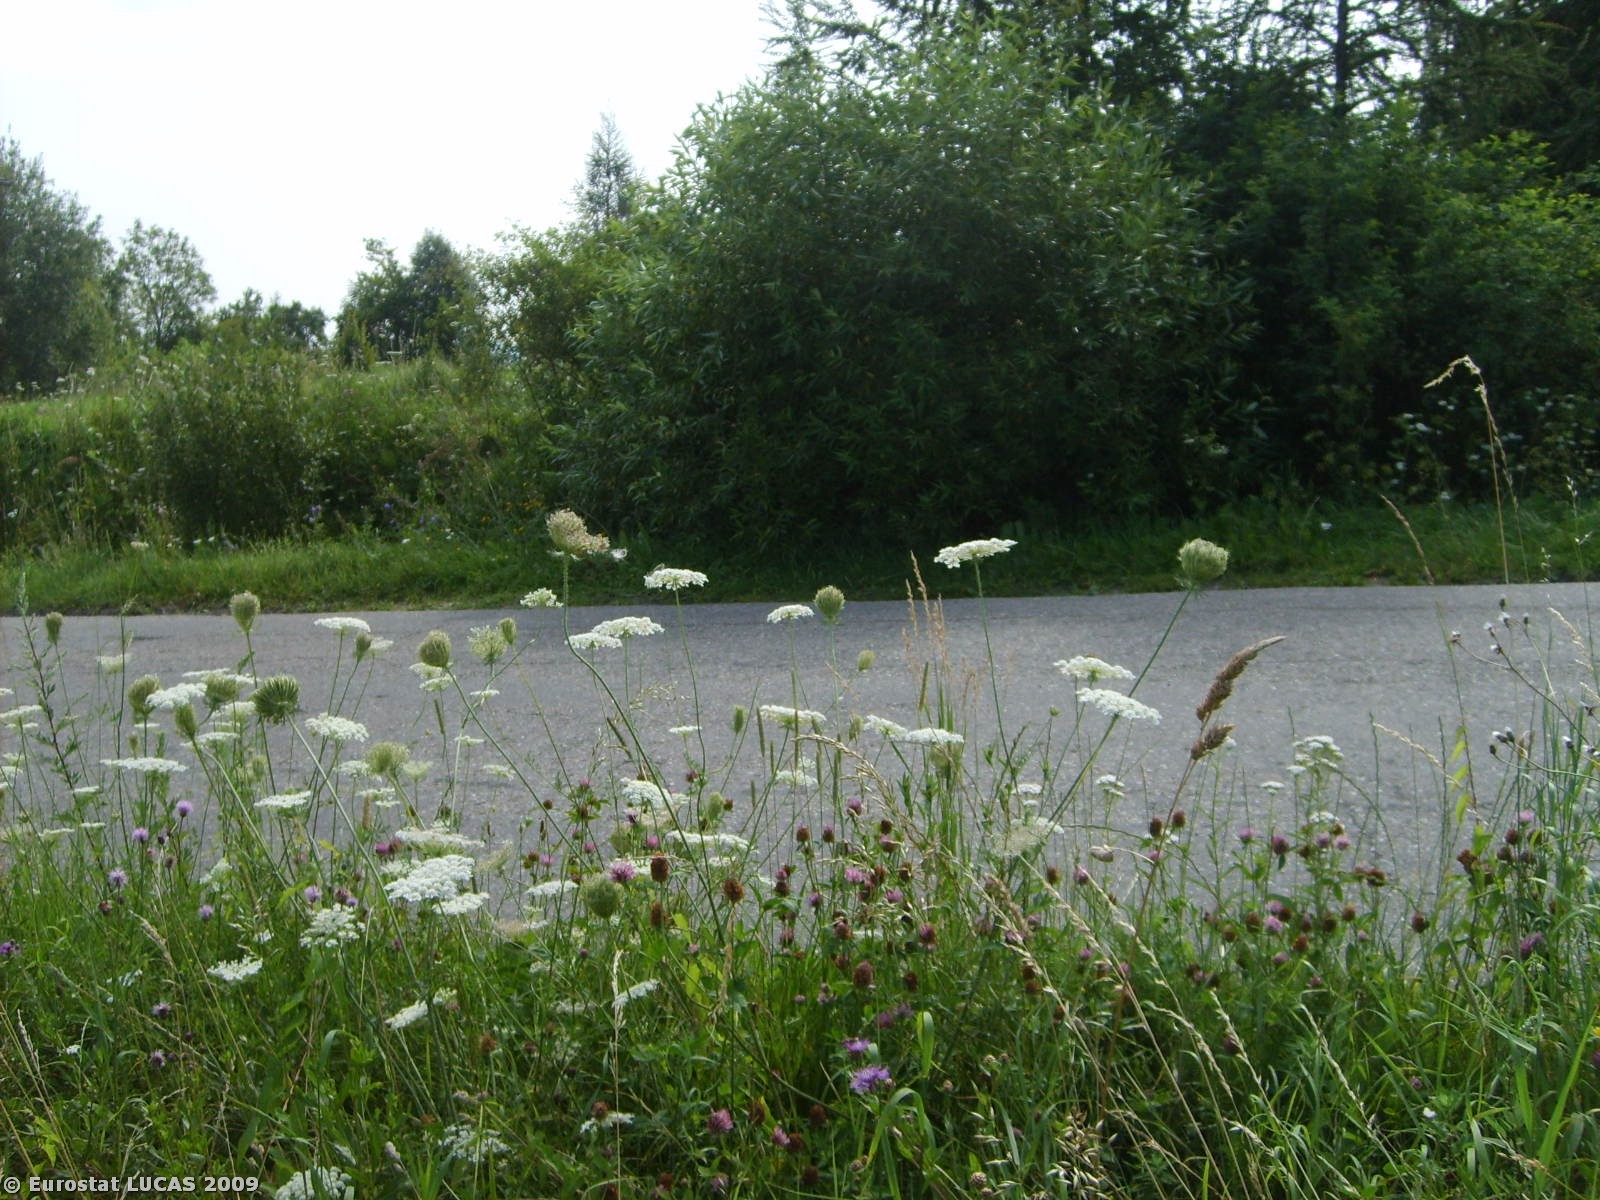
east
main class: Grassland
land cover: Spontaneously vegetated surfaces
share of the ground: > 75 %
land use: Unused
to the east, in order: Spontaneously vegetated surfaces; Paved roads, cycling and walking lanes; Grass margins; Ditches and canals; Grassland without tree/shrub cover; Shrubland with sparse tree cover; Grassland with sparse tree/shrub cover; Grassland without tree/shrub cover; Electric lines; Grassland without tree/shrub cover; Shrubland with sparse tree cover
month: July
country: PL
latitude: 49.8224
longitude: 21.0949
